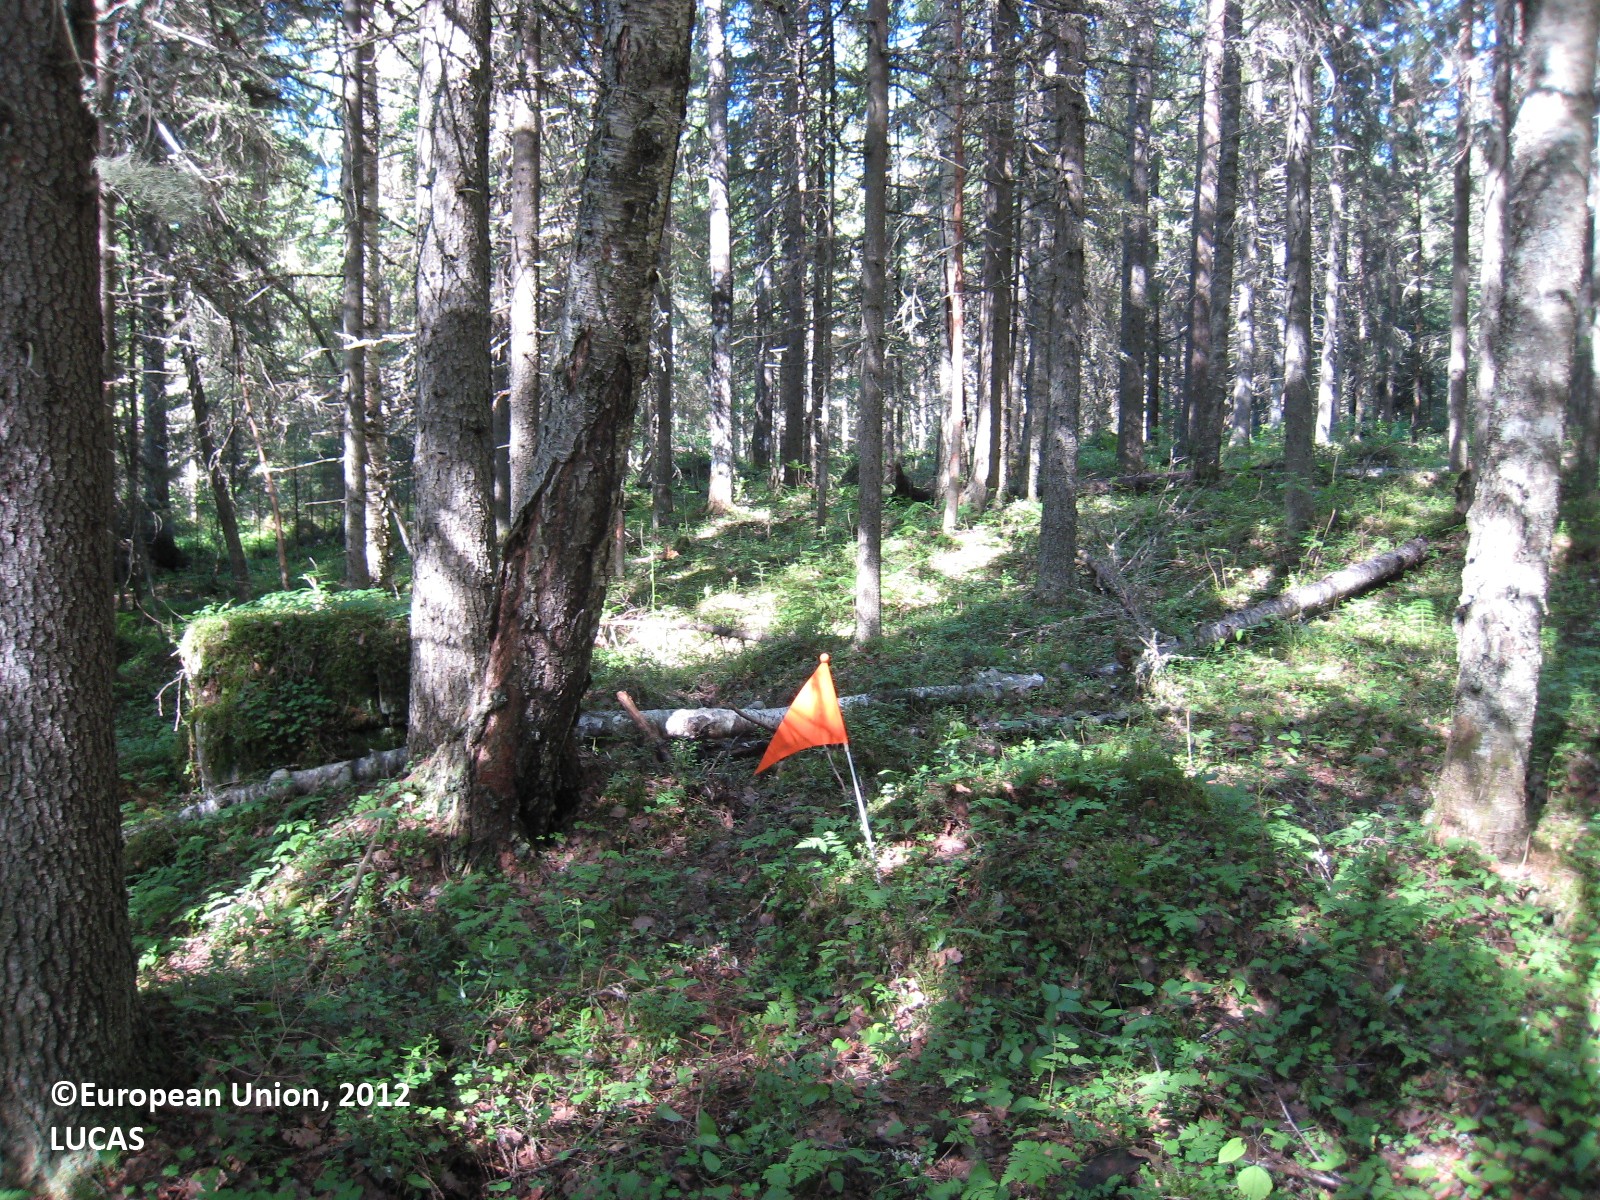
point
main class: Woodland
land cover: Spruce dominated mixed woodland
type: boreal forest
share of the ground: > 75 %
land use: Semi-natural and natural areas not in use
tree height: > 5 m
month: July
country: FI
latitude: 63.1938
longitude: 26.8144
